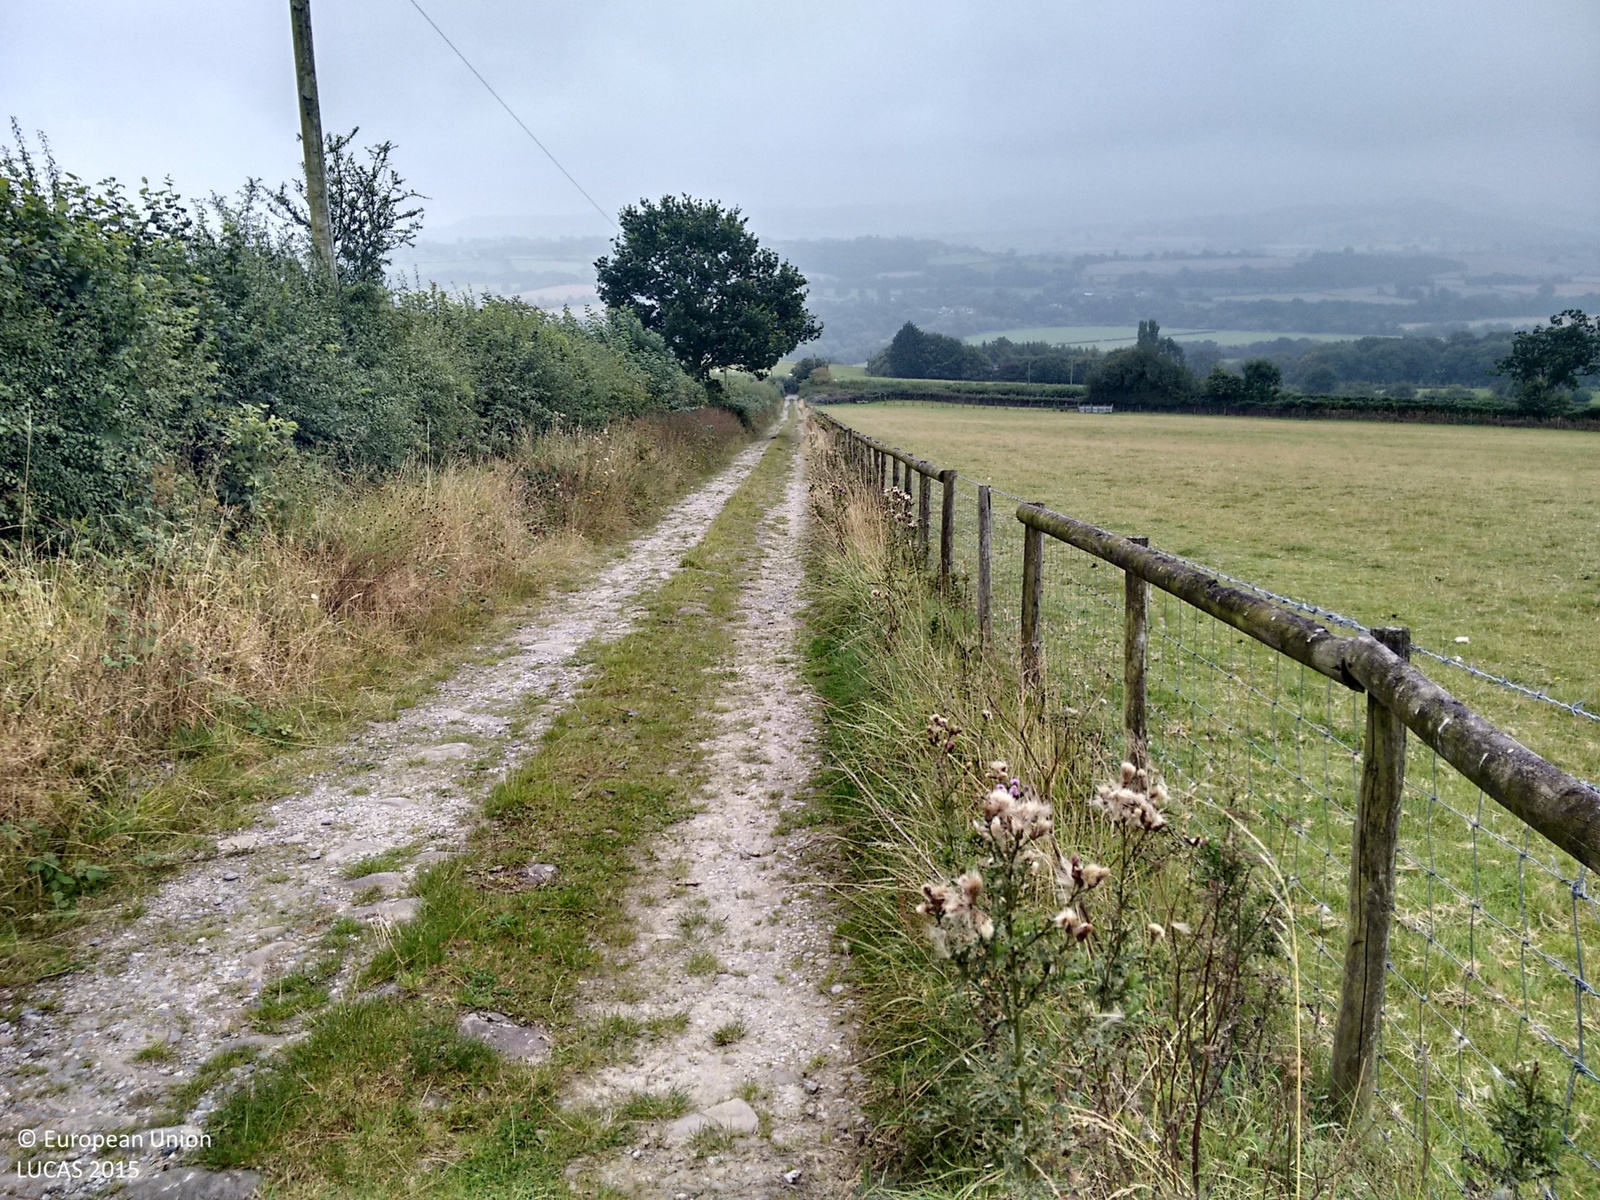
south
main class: Grassland
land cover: Grassland without tree/shrub cover
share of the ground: > 75 %
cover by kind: herbaceous plants 100 %
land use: Agriculture (excluding fallow land and kitchen gardens)
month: September
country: GB
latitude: 52.1191
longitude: -3.1193
